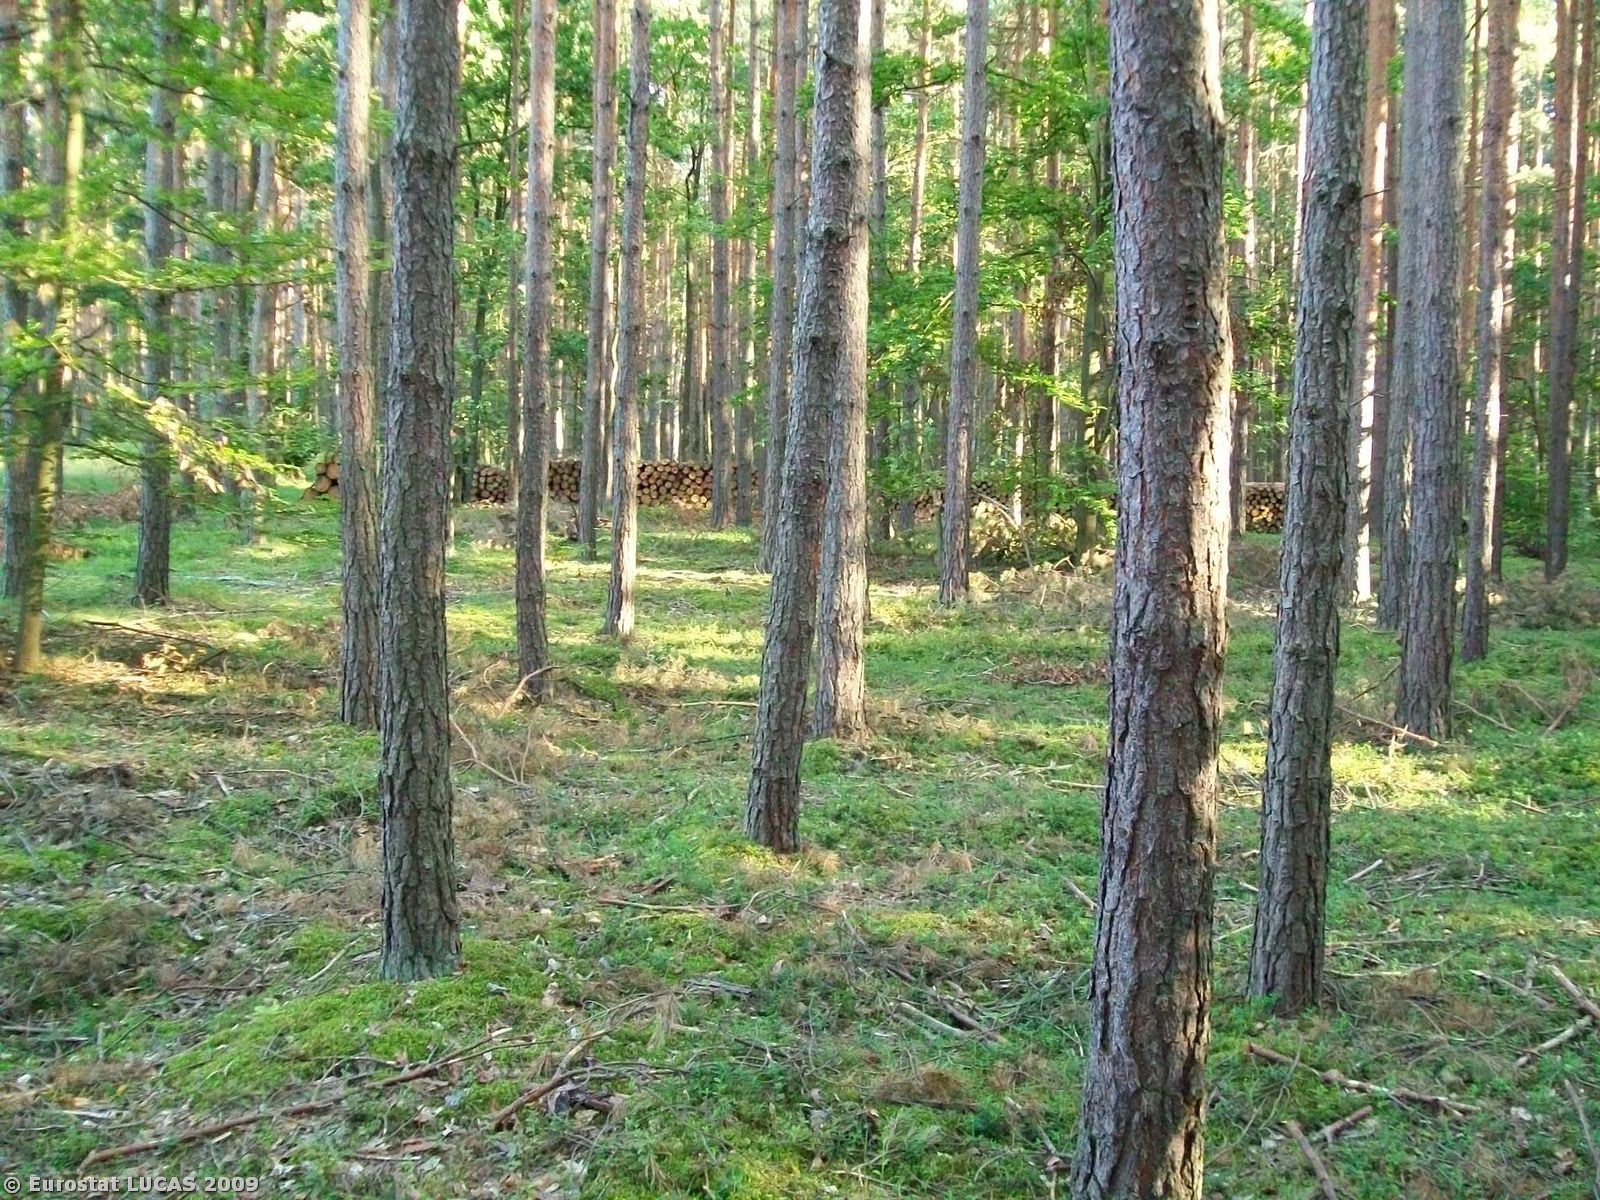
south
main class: Woodland
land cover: Mixed woodland
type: hemiboreal forest and nemoral coniferous forest and mixed broadleaved-coniferous forest
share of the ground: > 75 %
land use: Forestry
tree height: > 5 m
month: August
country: PL
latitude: 51.0294
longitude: 17.6421
